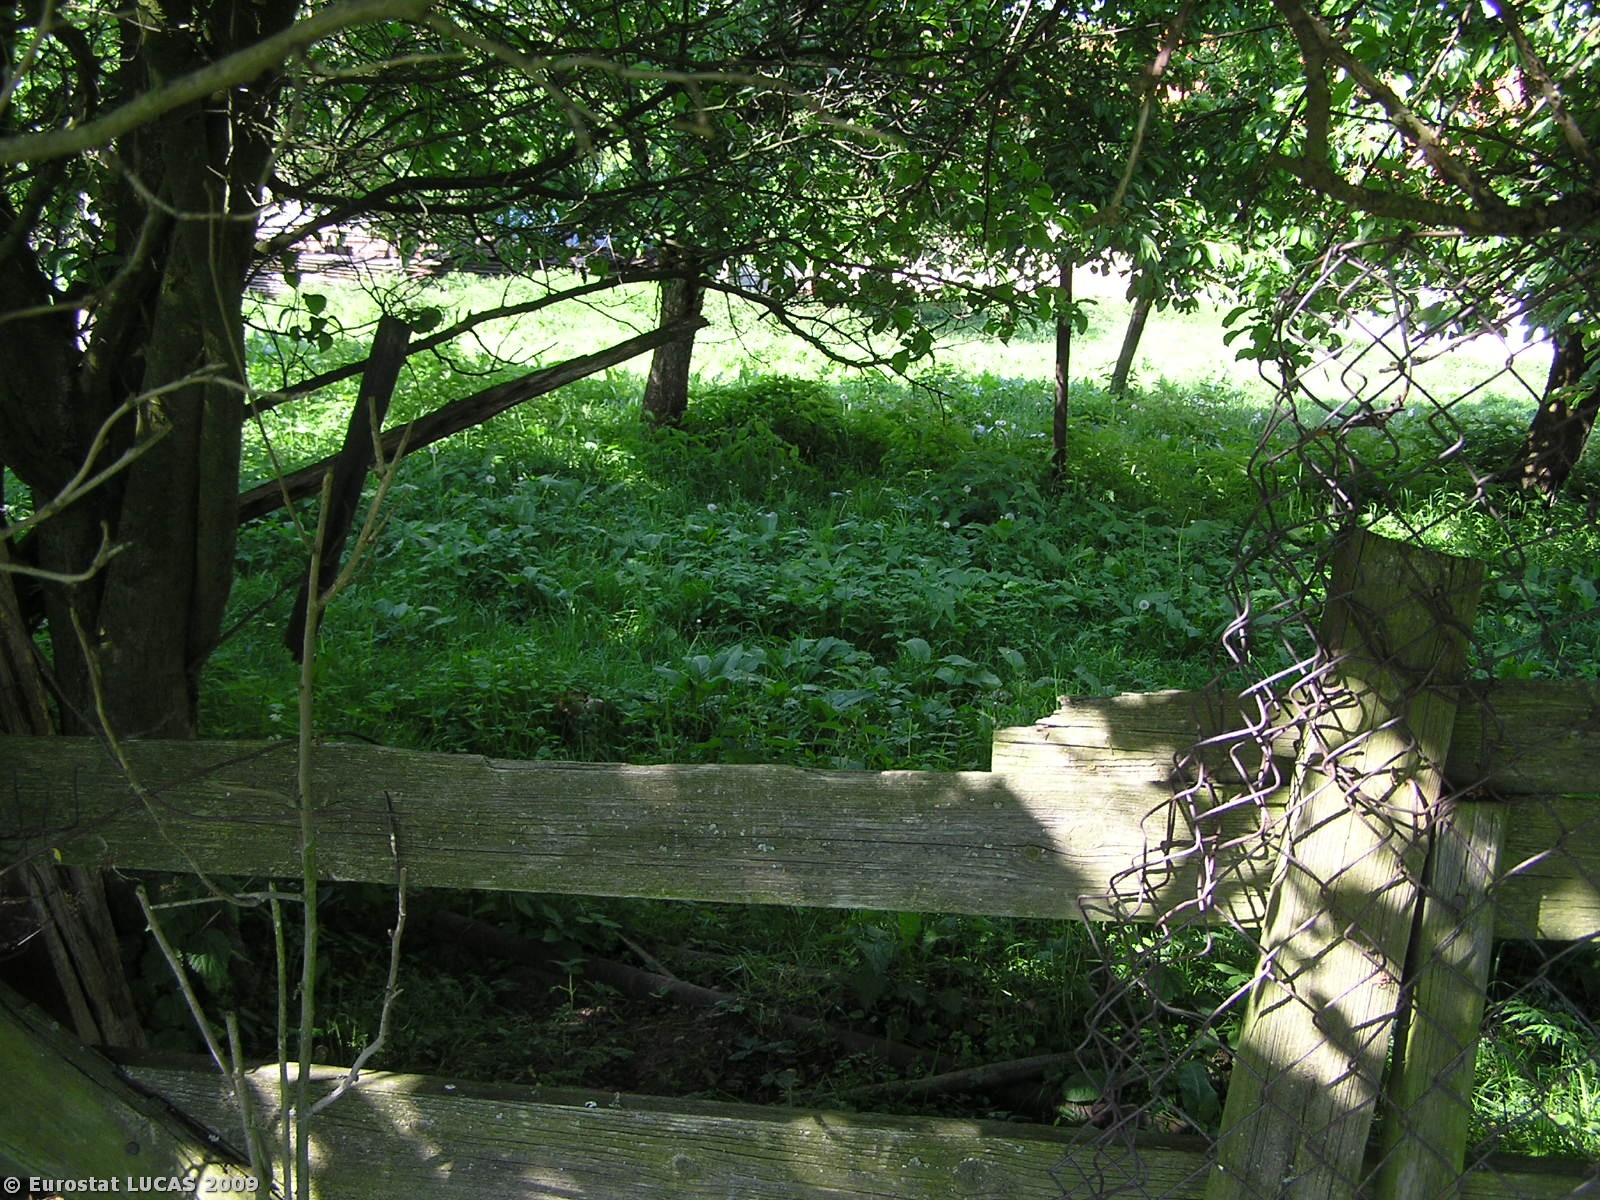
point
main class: Cropland
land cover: Apple fruit
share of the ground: 50 - 75 %
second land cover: Grassland with sparse tree/shrub cover
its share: > 75 %
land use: Kitchen garden
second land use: Amenities, museums, leisure
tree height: > 5 m
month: May
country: CZ
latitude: 49.6158
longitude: 14.7771
